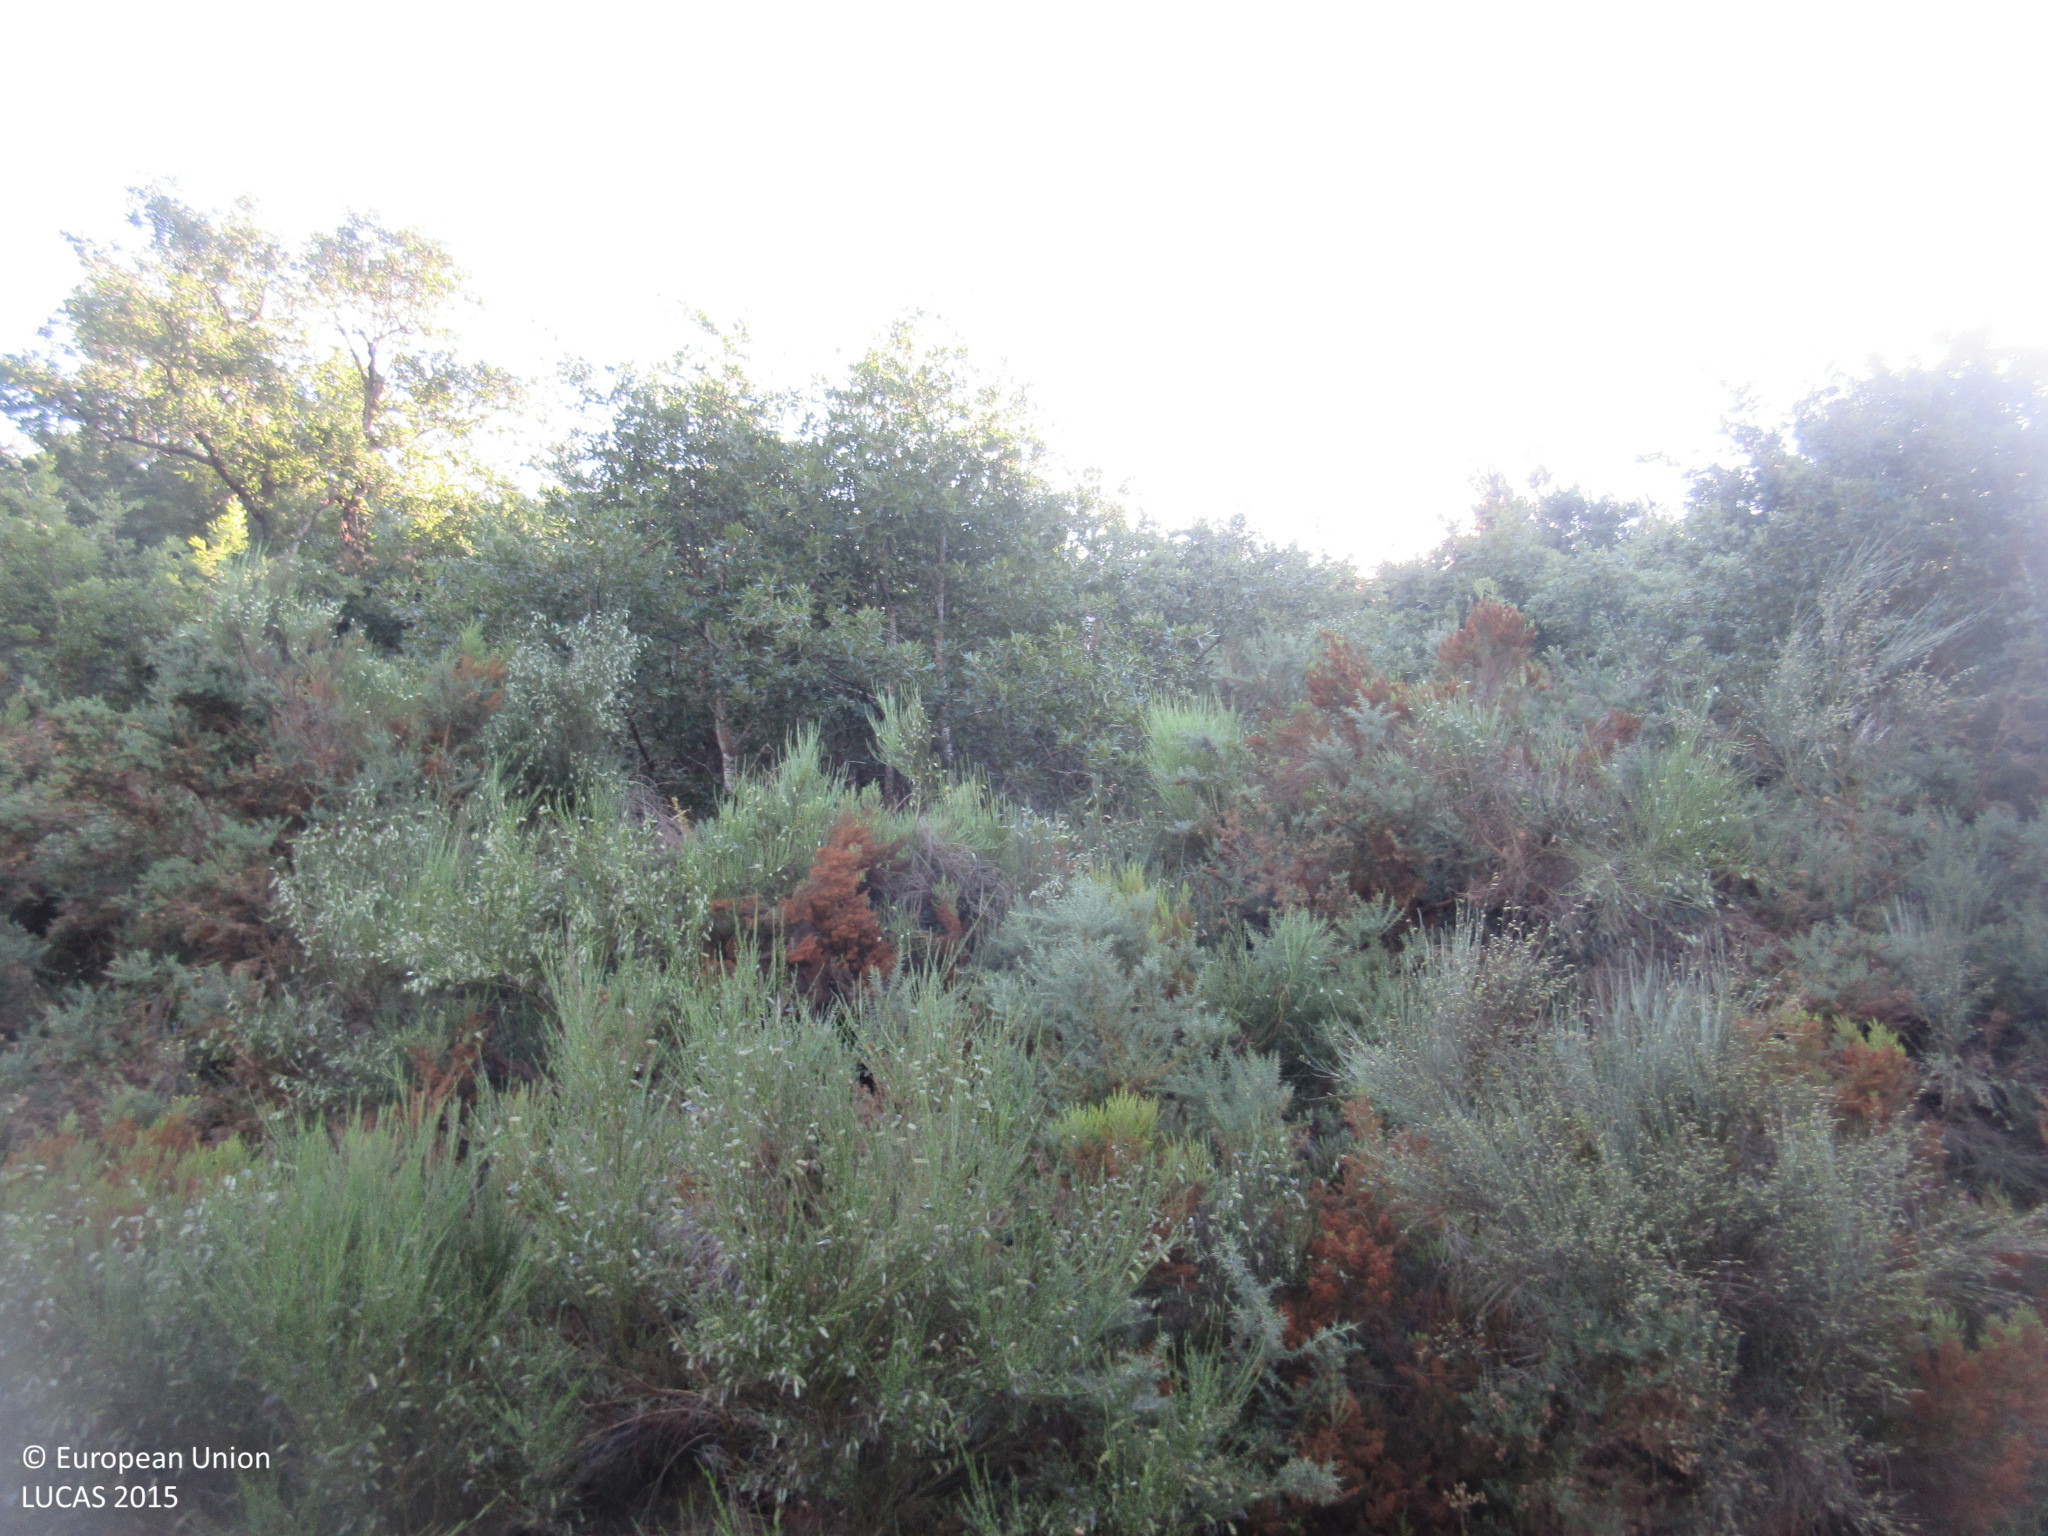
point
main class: Woodland
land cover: Broadleaved woodland
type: acidophilous oak and oak-birch forest
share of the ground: > 75 %
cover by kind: broadleaved forest trees 90 %, shrubs 10 %
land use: Forestry
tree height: > 5 m
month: June
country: ES
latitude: 43.2008
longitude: -7.0619
